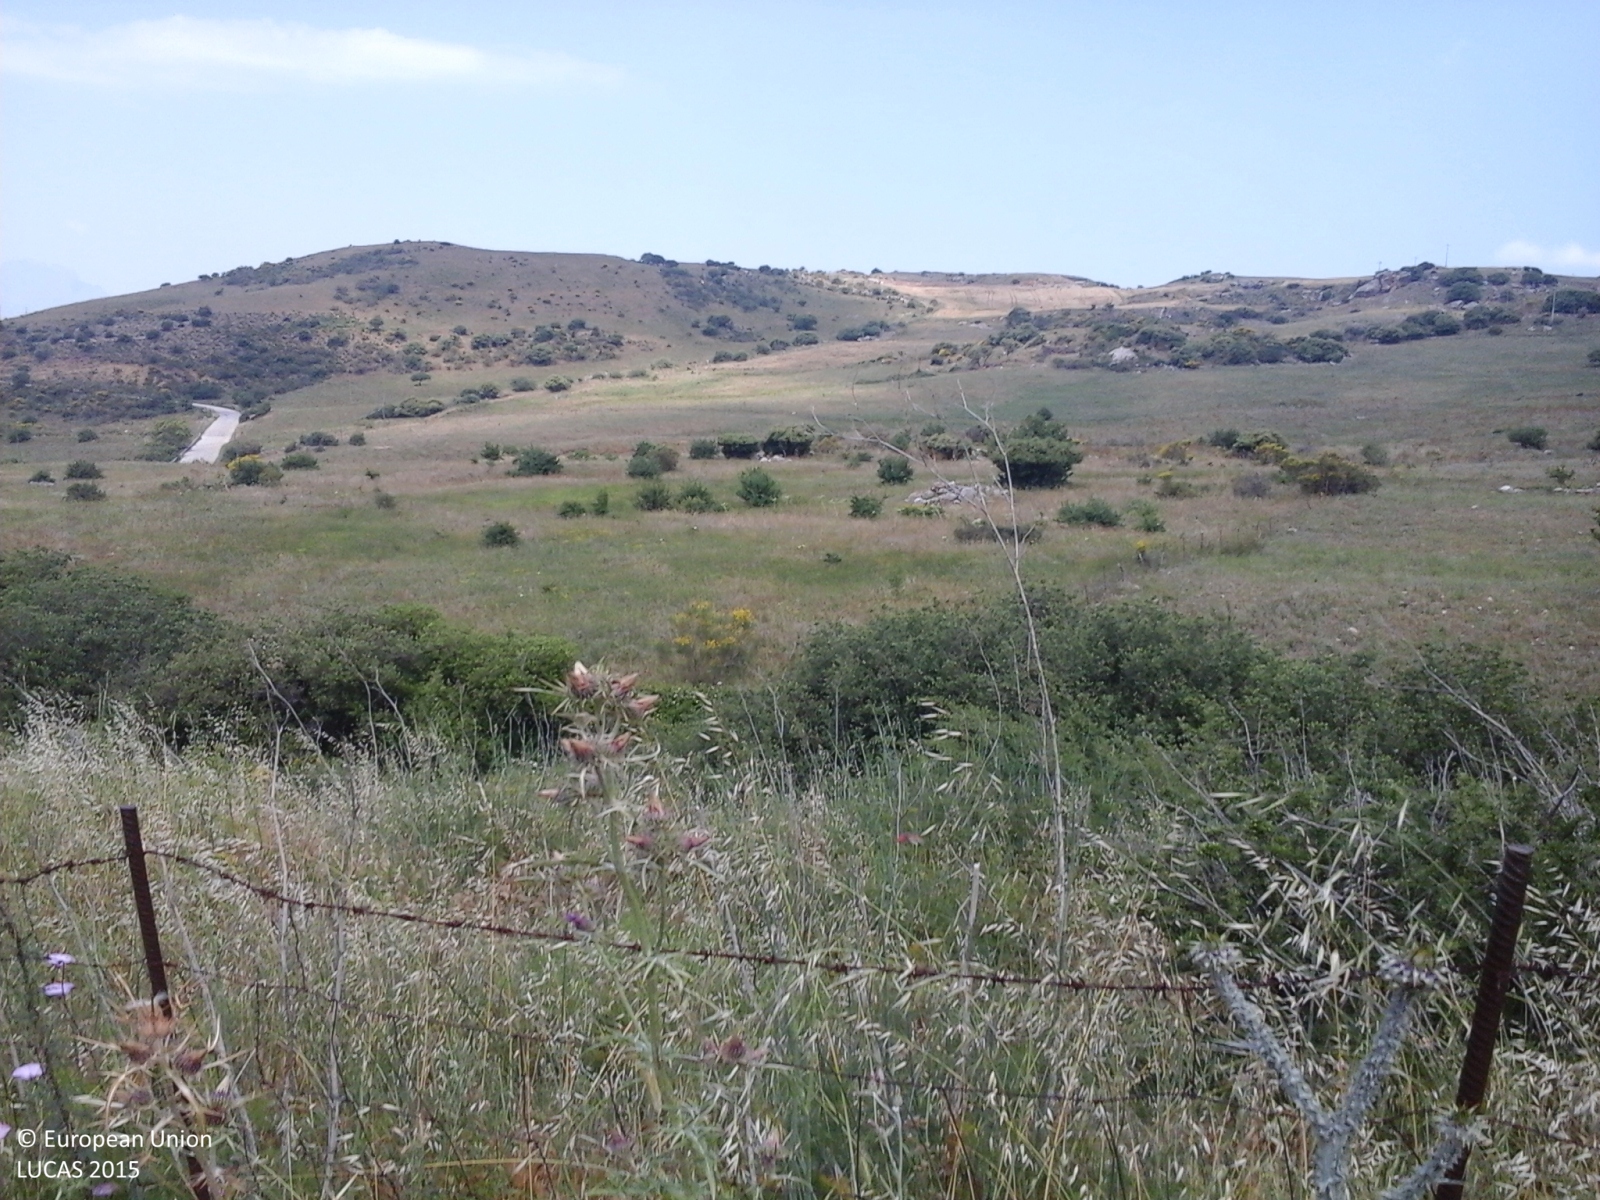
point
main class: Grassland
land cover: Grassland with sparse tree/shrub cover
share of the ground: > 75 %
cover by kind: herbaceous plants 85 %, shrubs 10 %, broadleaved forest trees 5 %
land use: Agriculture (excluding fallow land and kitchen gardens)
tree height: < 5 m
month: June
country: IT
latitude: 37.8849
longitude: 13.9176
